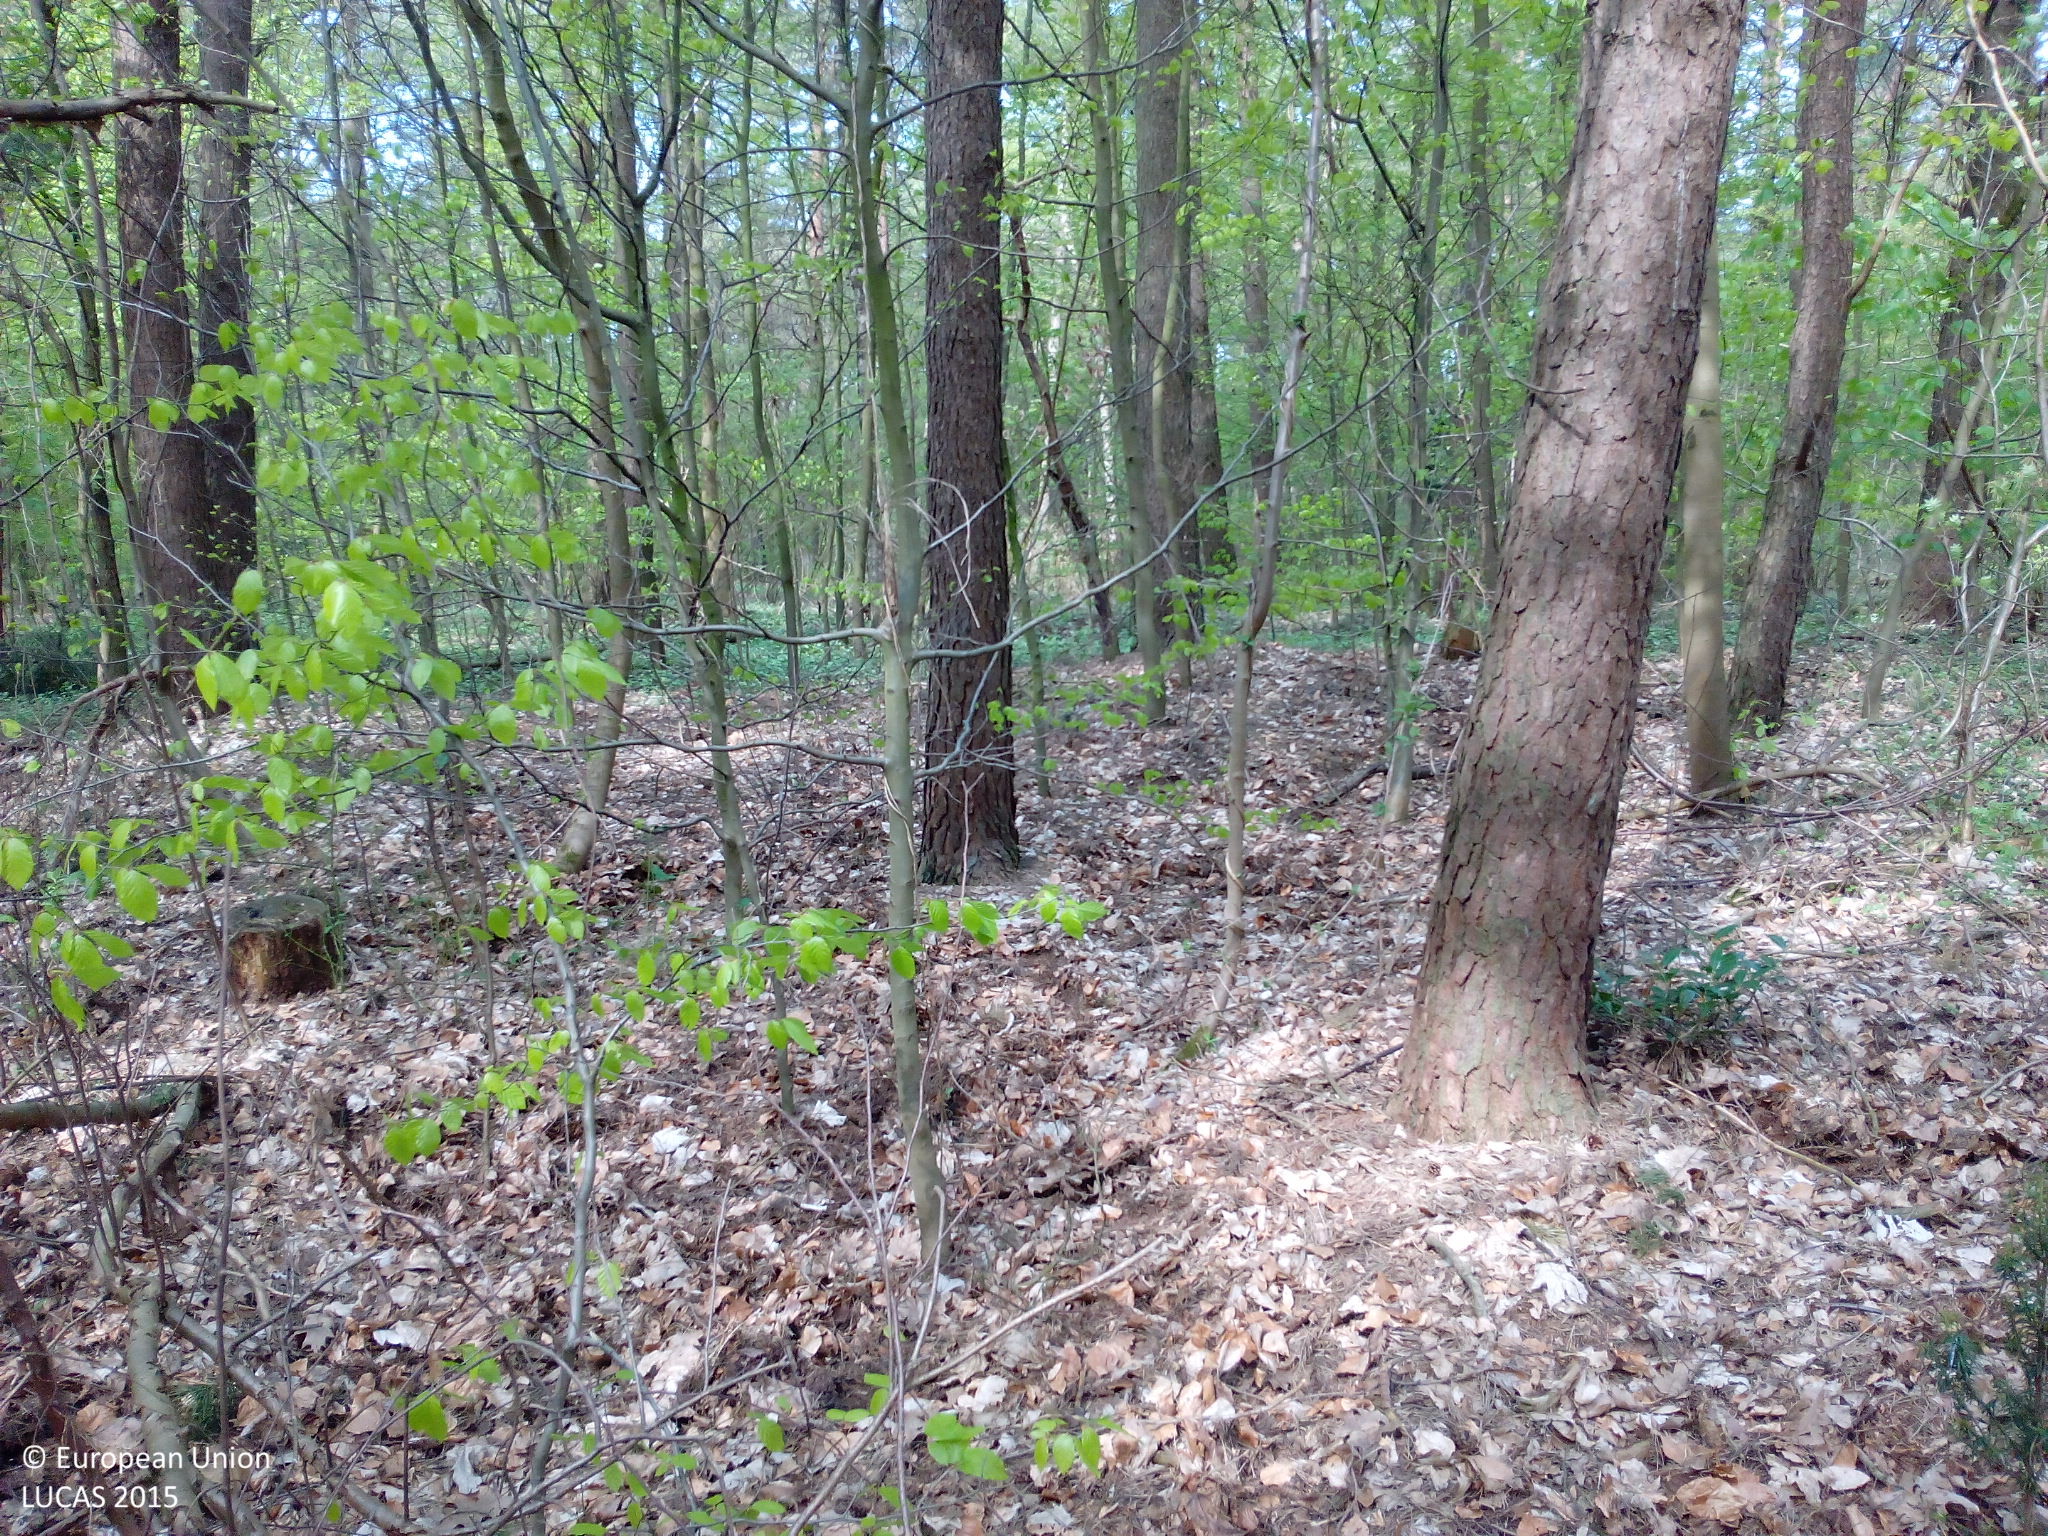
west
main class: Woodland
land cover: Pine dominated mixed woodland
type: hemiboreal forest and nemoral coniferous forest and mixed broadleaved-coniferous forest
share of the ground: > 75 %
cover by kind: coniferous forest trees 65 %, broadleaved forest trees 25 %, herbaceous plants 10 %
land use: Forestry
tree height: > 5 m
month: May
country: DE
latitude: 53.2138
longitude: 8.5780
